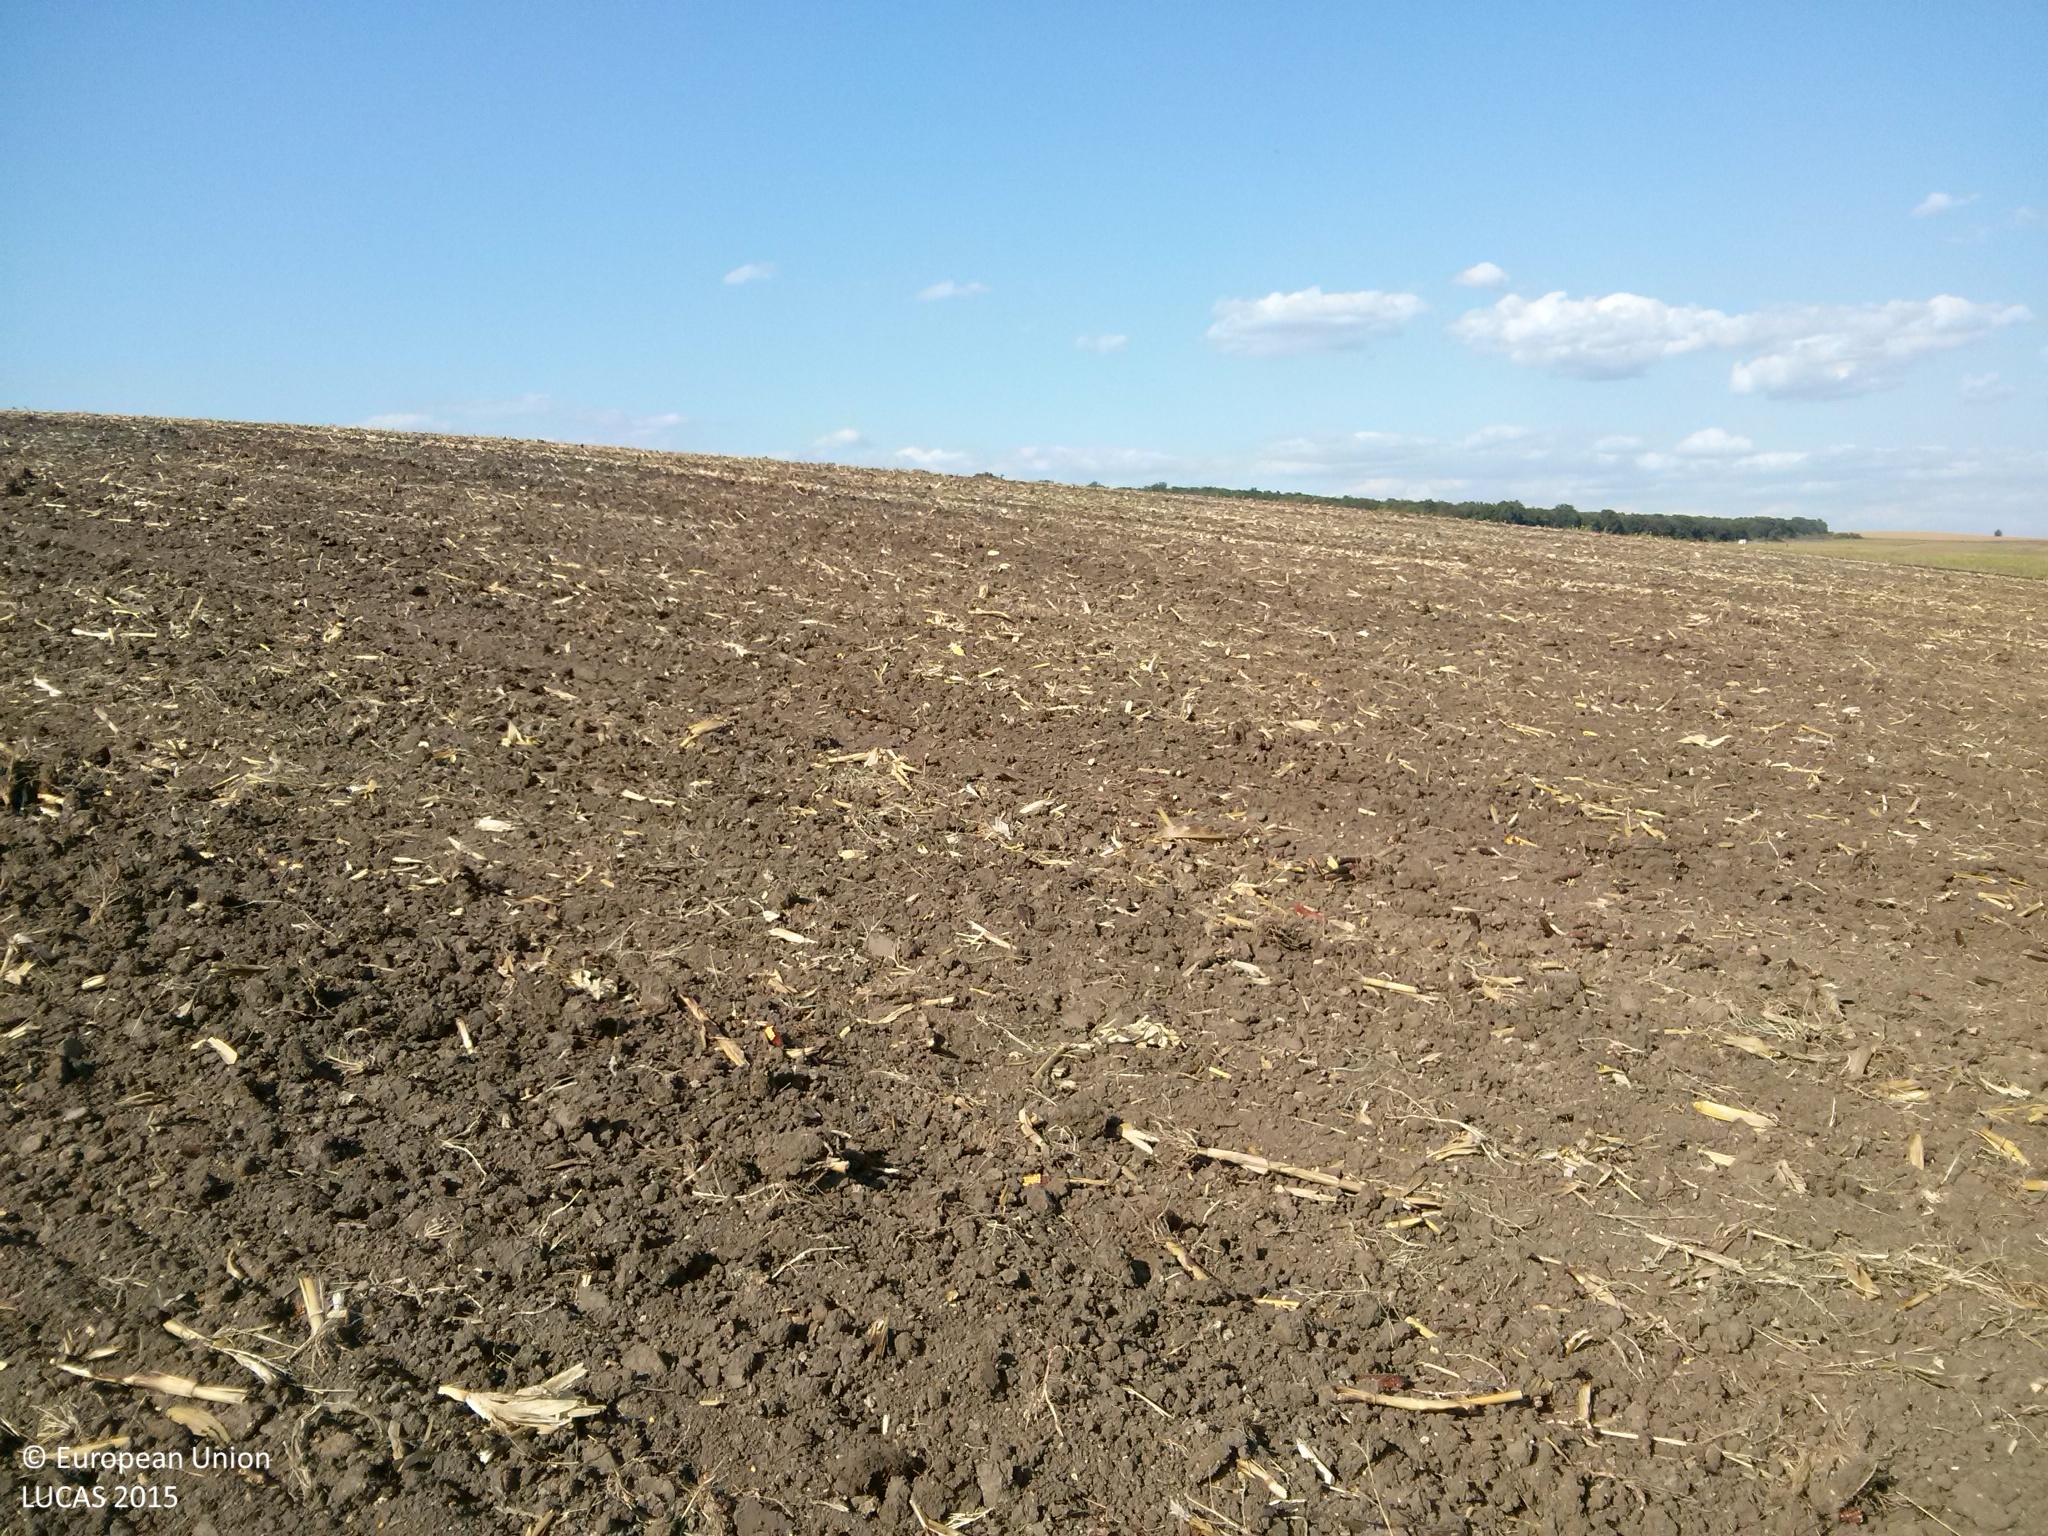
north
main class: Cropland
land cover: Maize
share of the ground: < 10 %
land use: Agriculture (excluding fallow land and kitchen gardens)
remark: Harvested field
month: September
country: BG
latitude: 43.9038
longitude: 26.4815
